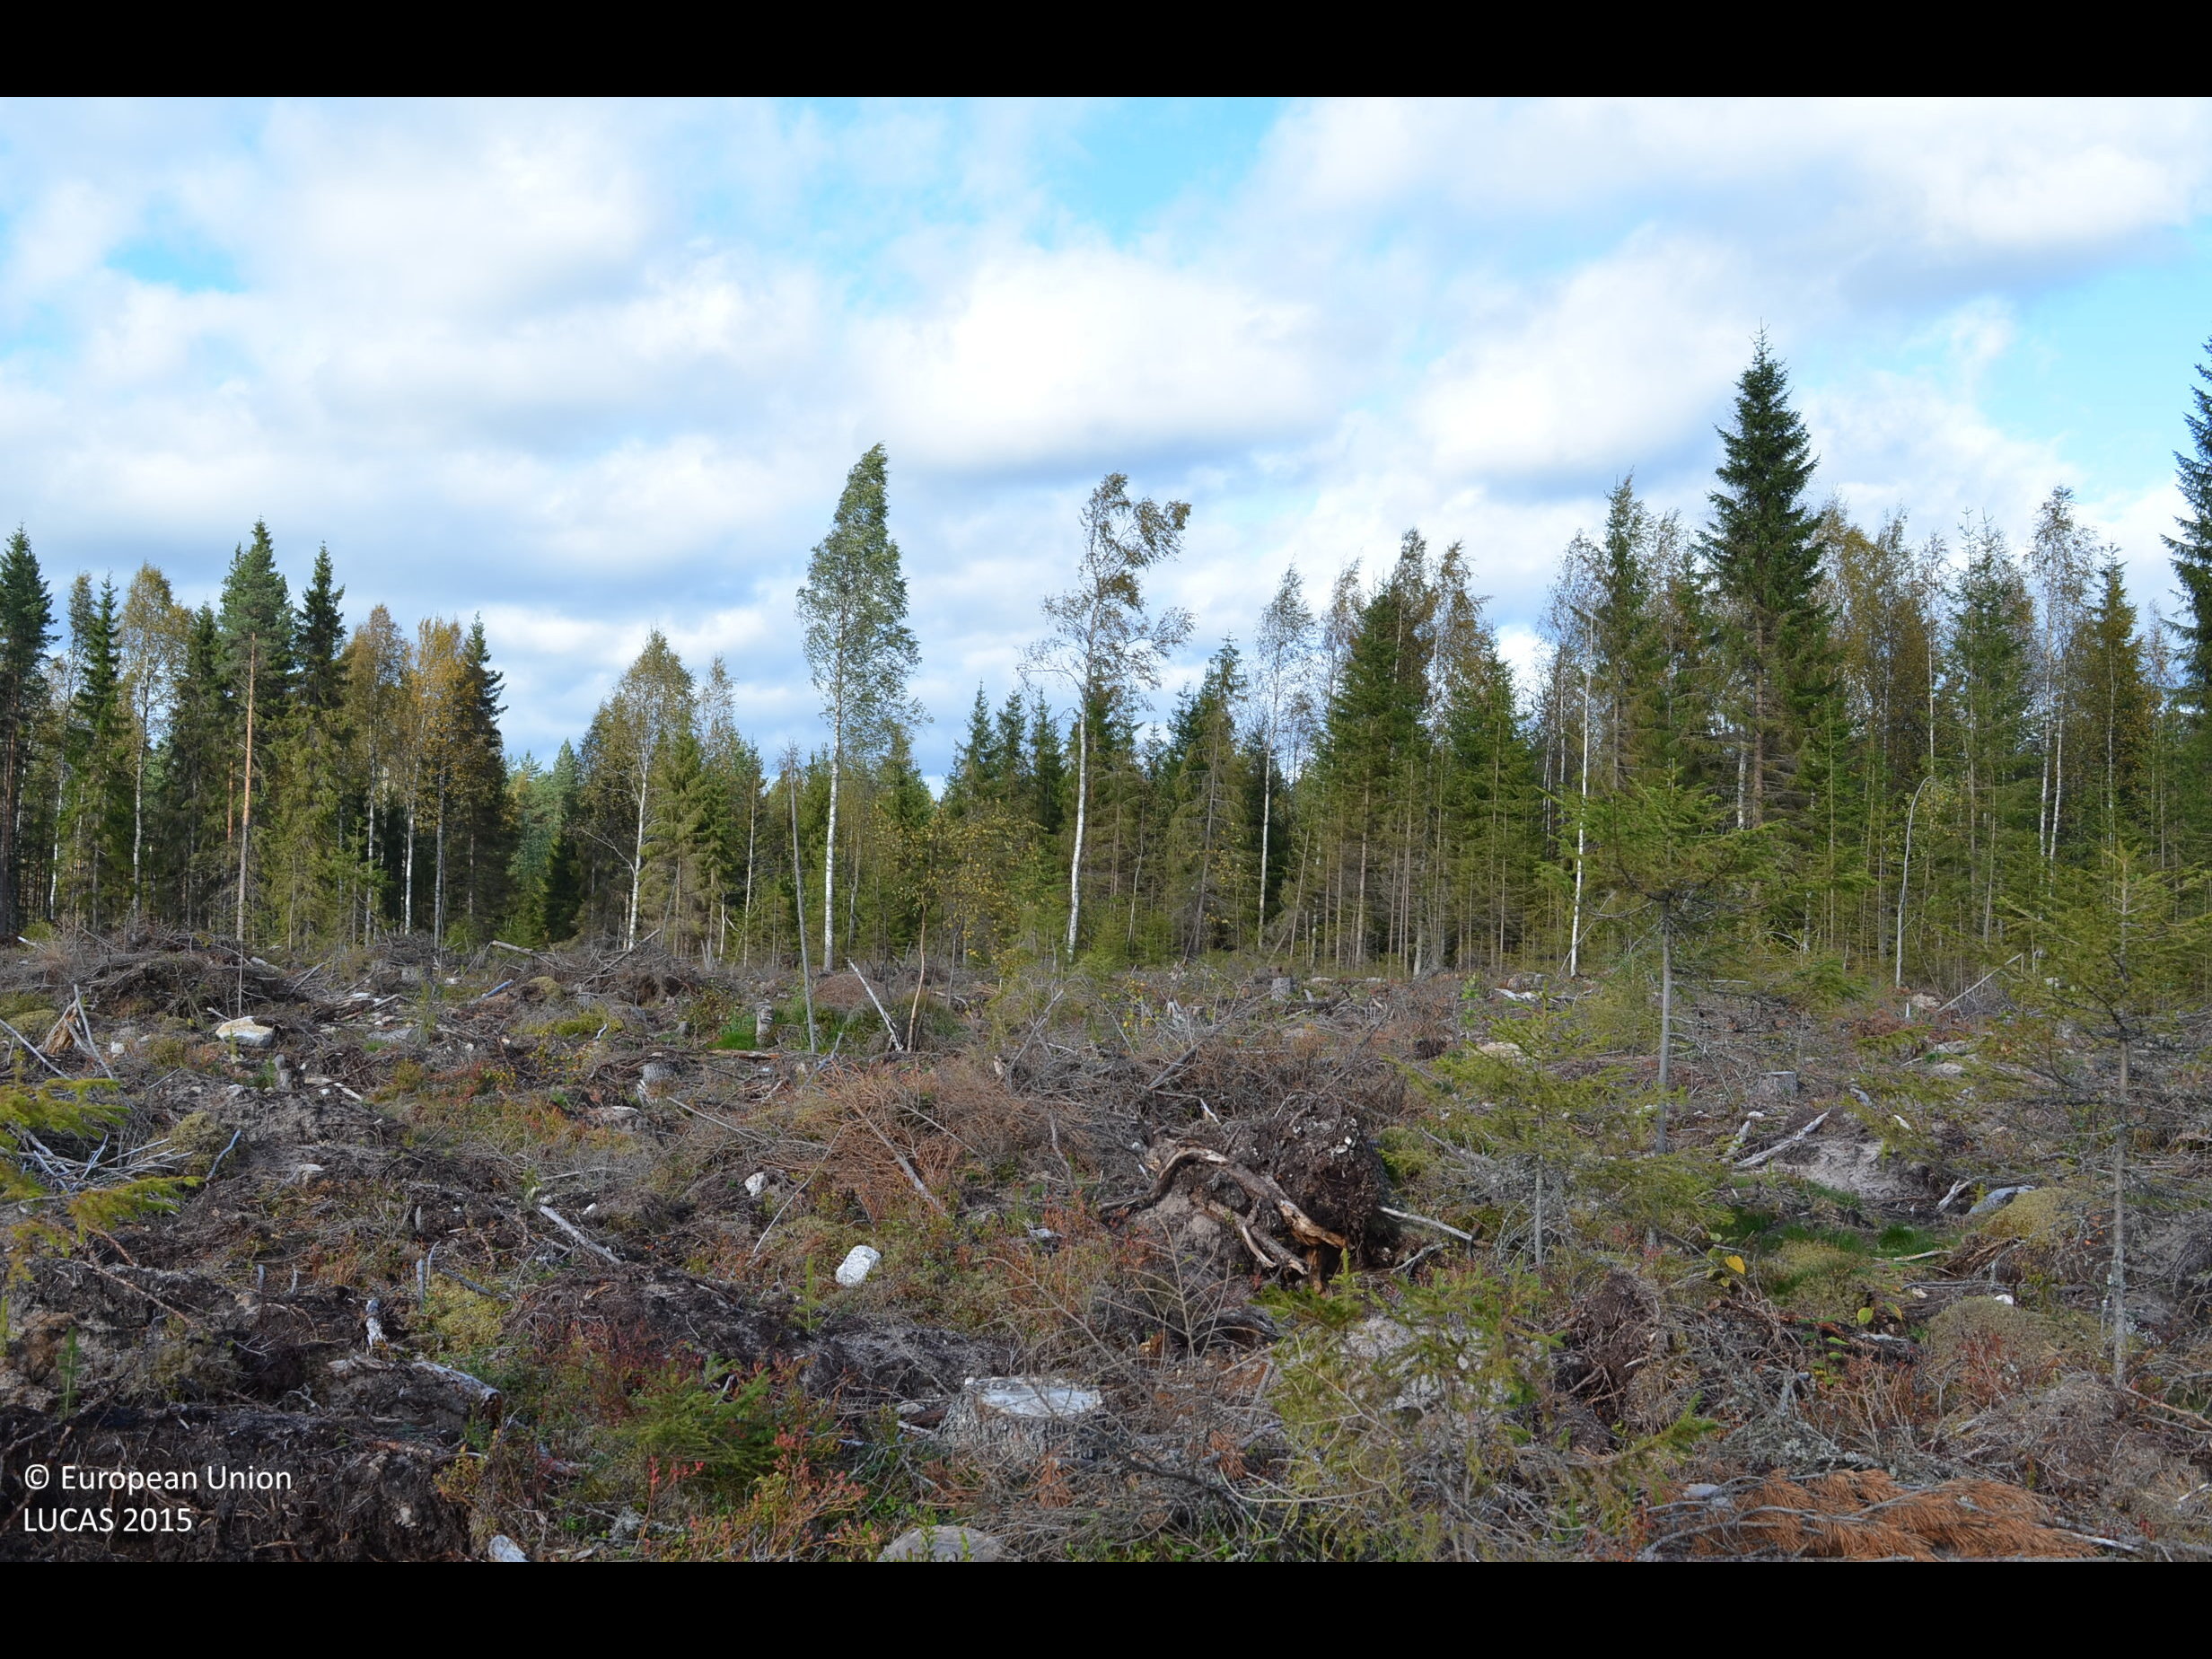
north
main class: Shrubland
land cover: Shrubland without tree cover
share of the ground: 10 - 25 %
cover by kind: unconsolidated bare surface 50 %, shrubs 10 %, lichens and mosses 10 %
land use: Forestry
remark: Clear cut
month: September
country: FI
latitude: 62.9066
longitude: 23.8301
